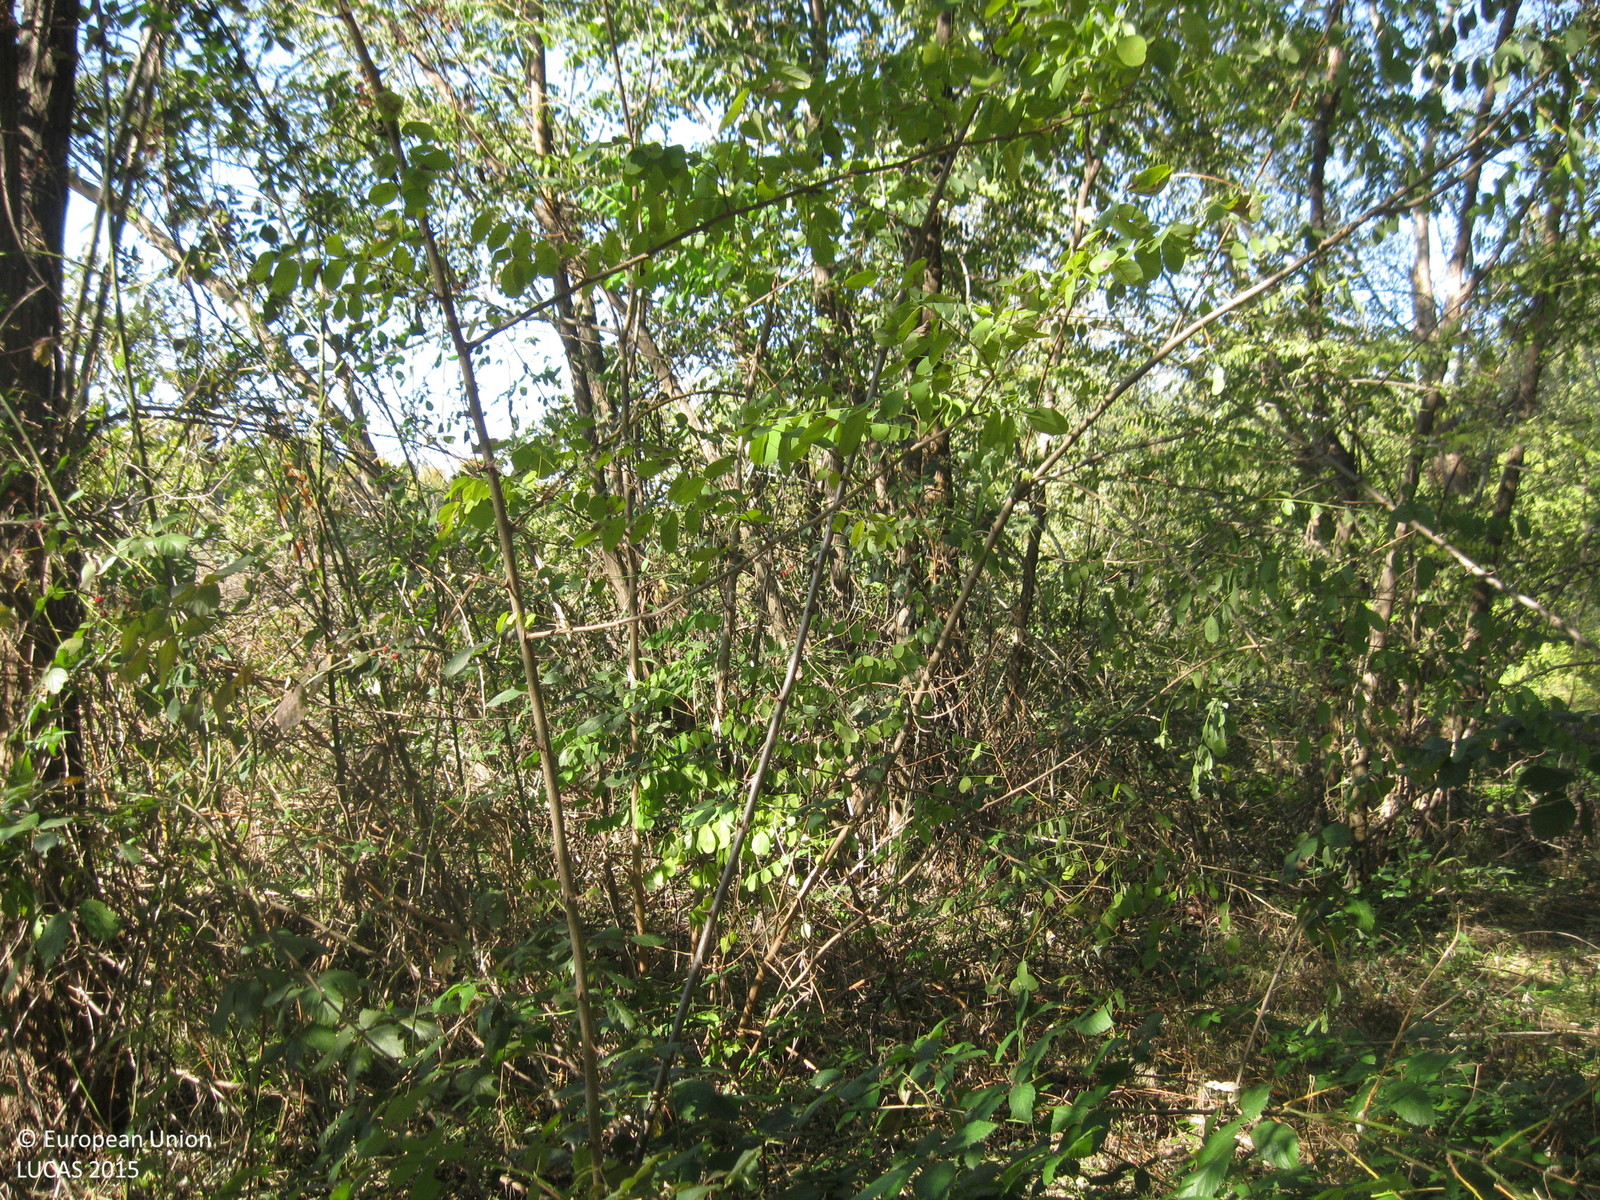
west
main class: Woodland
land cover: Broadleaved woodland
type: floodplain forest
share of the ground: > 75 %
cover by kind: broadleaved forest trees 90 %, shrubs 10 %
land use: Semi-natural and natural areas not in use
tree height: > 5 m
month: November
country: BG
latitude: 42.3835
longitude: 24.0465
